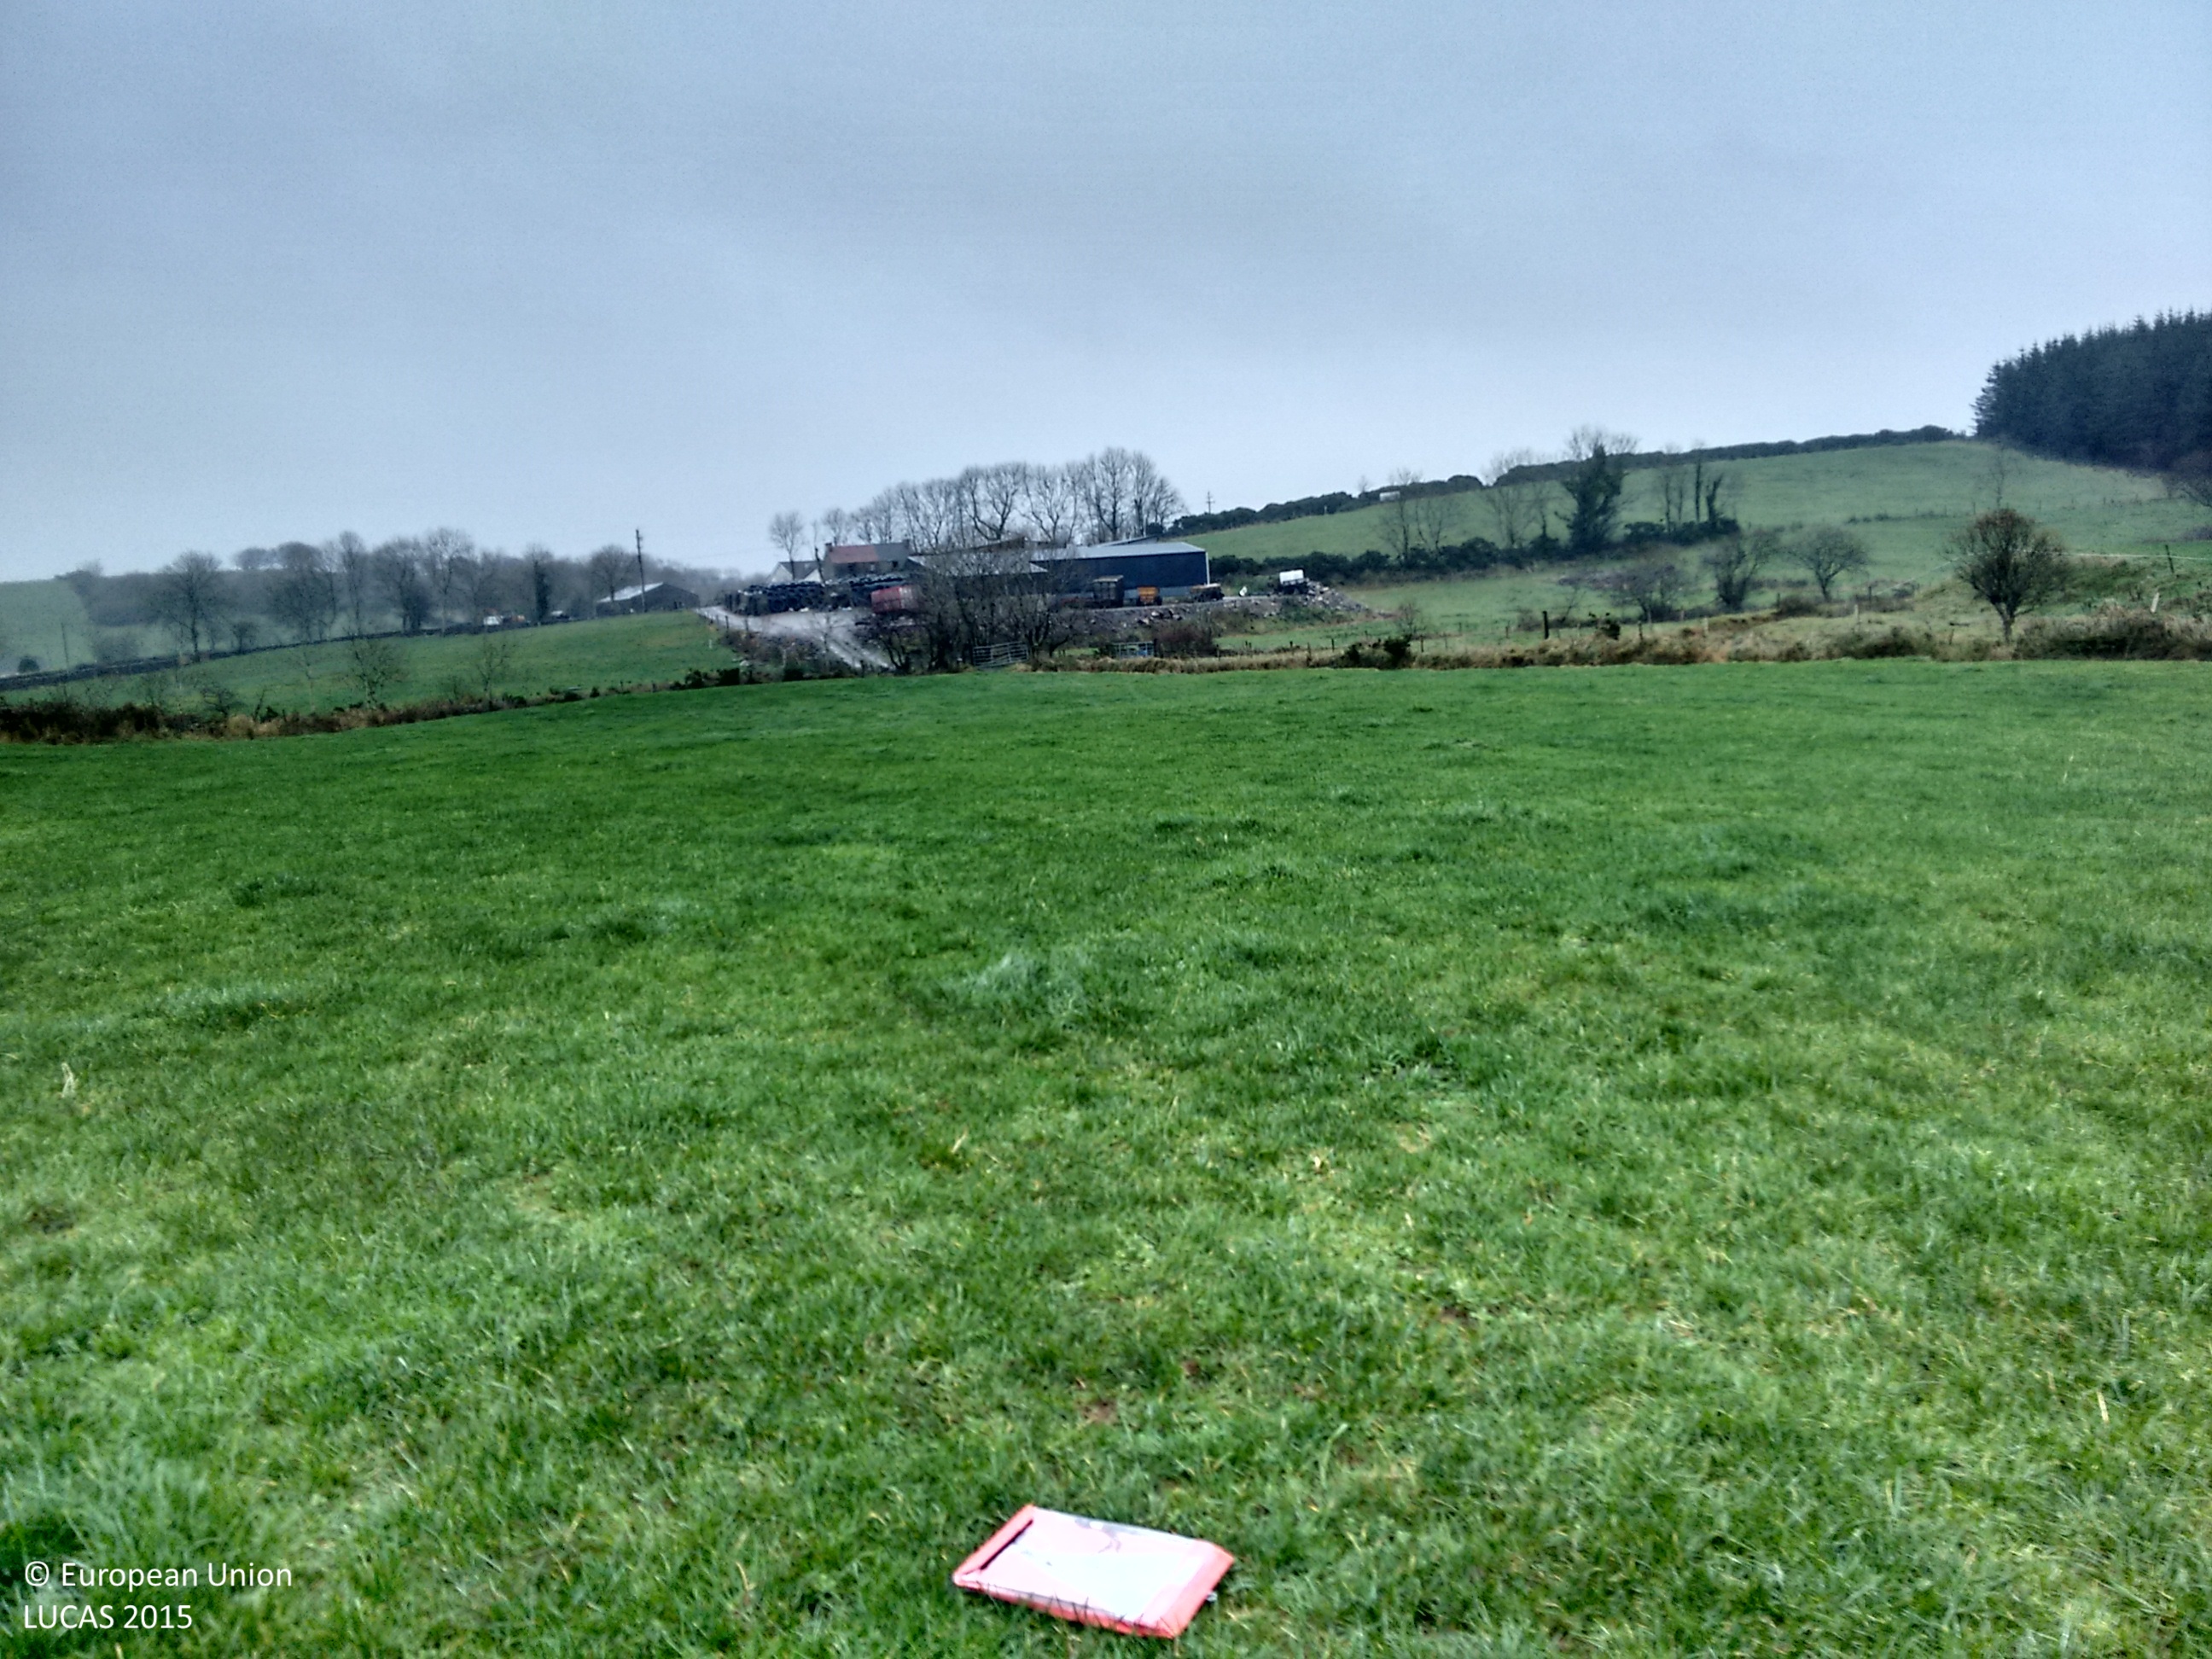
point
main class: Grassland
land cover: Grassland without tree/shrub cover
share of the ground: > 75 %
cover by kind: herbaceous plants 100 %
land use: Agriculture (excluding fallow land and kitchen gardens)
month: November
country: IE
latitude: 54.5341
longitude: -8.0875
